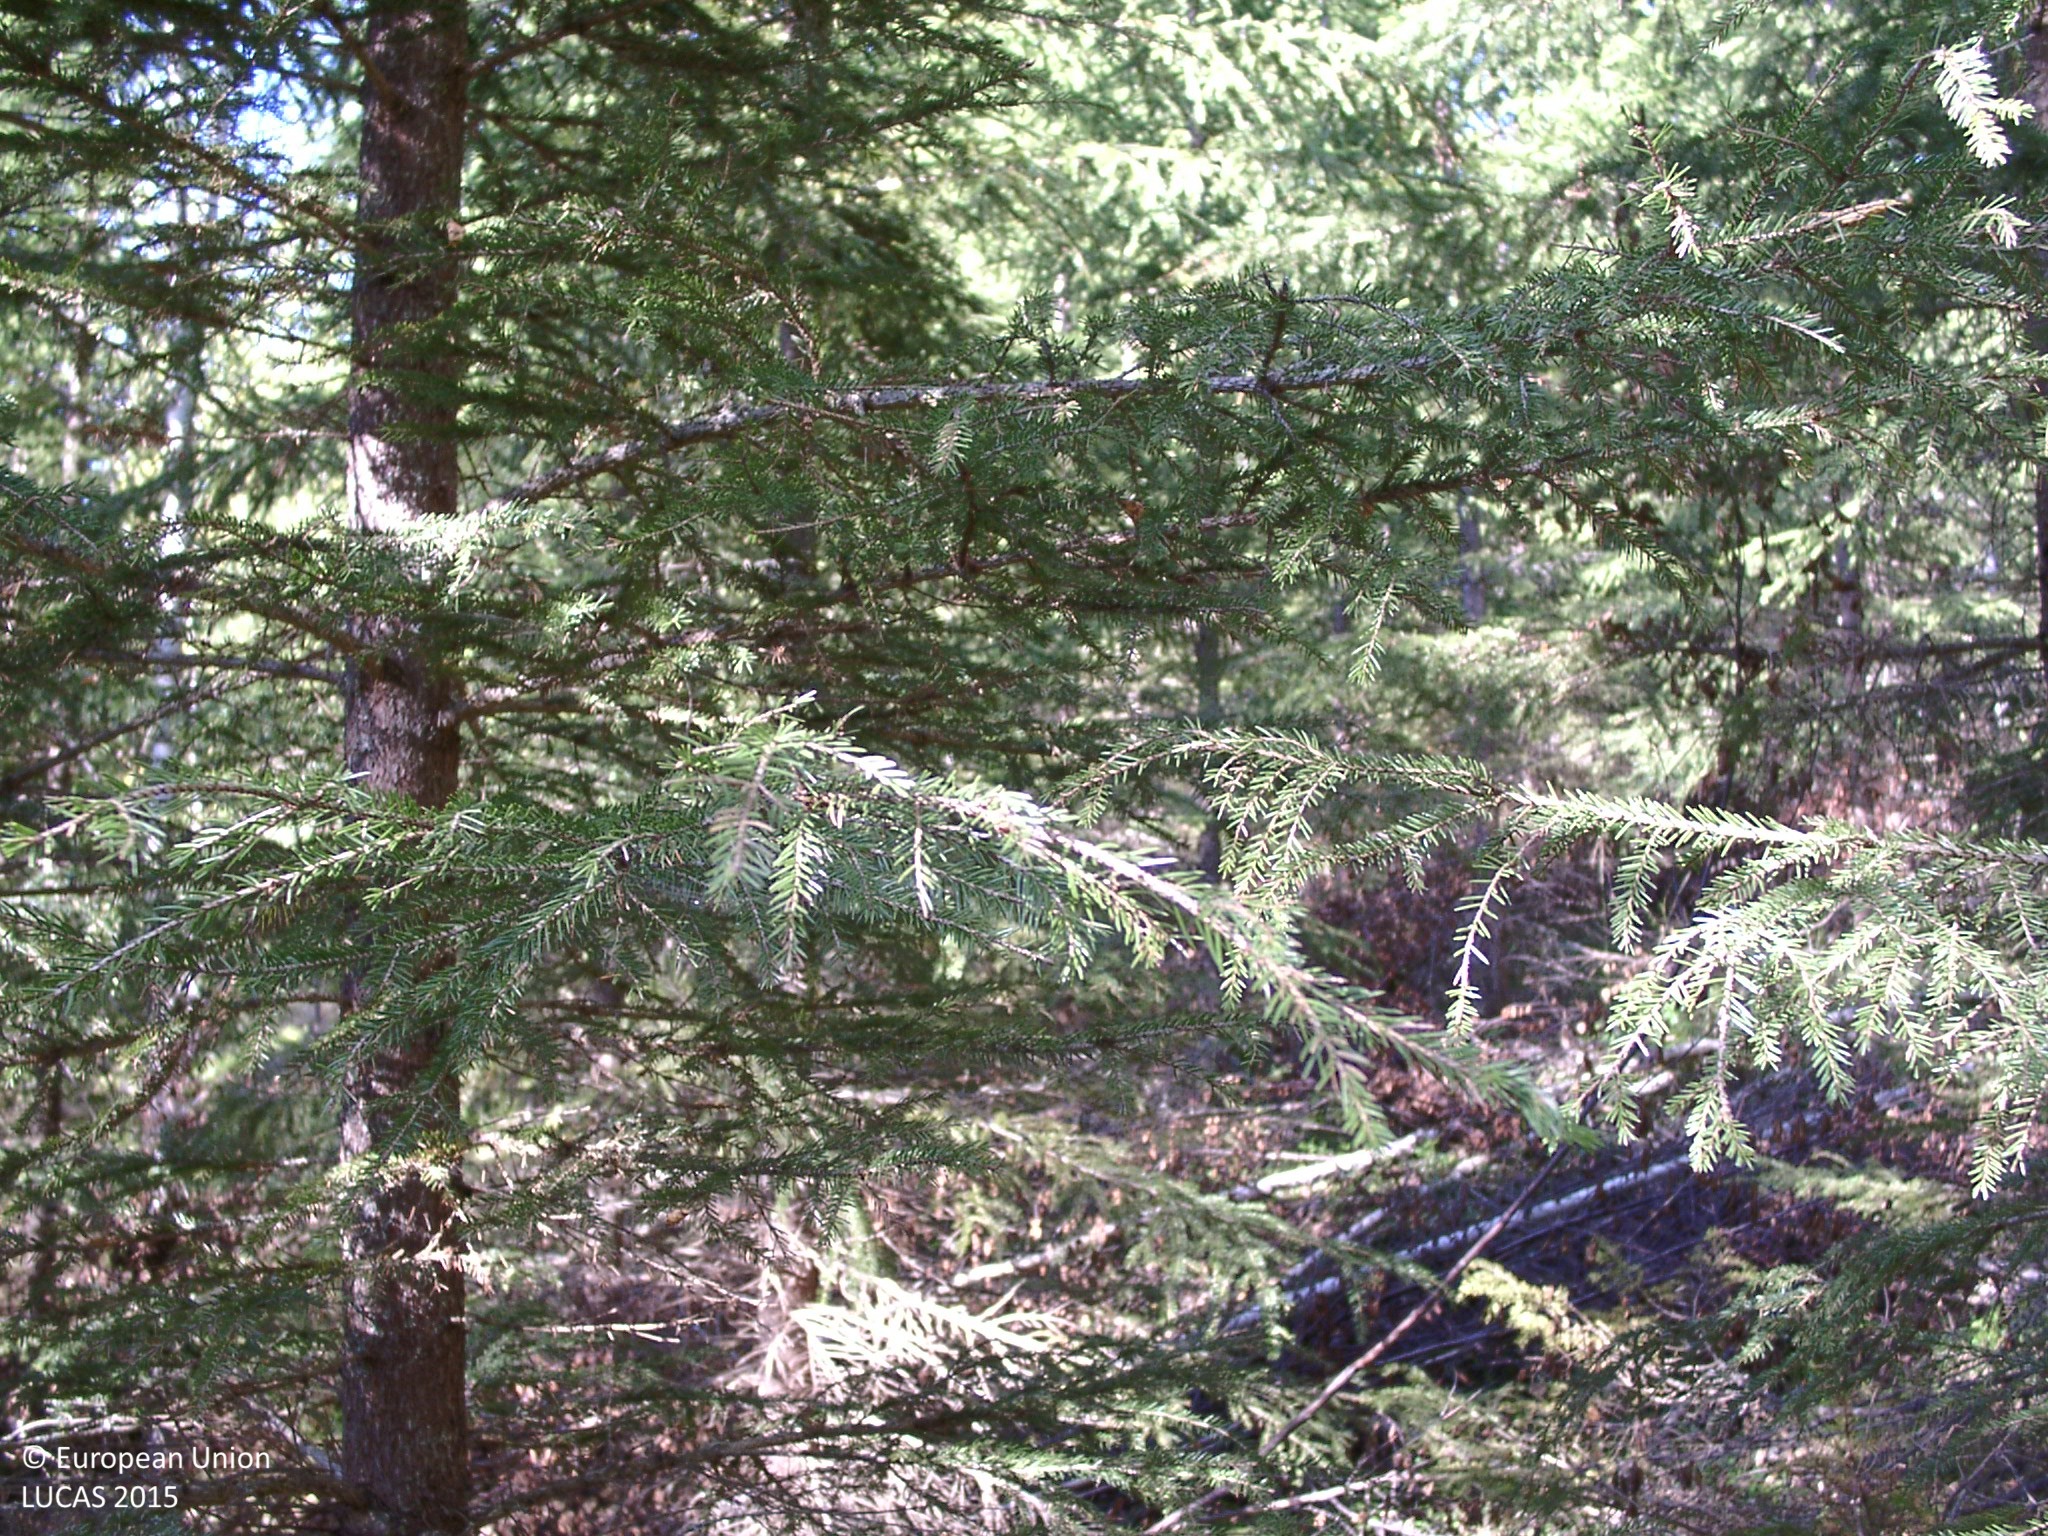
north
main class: Woodland
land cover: Spruce dominated coniferous woodland
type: boreal forest
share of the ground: 50 - 75 %
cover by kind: coniferous forest trees 60 %, broadleaved forest trees 5 %, herbaceous plants 5 %, lichens and mosses 5 %, unconsolidated bare surface 5 %
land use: Forestry
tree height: > 5 m
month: August
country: FI
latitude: 61.6949
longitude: 25.2953
